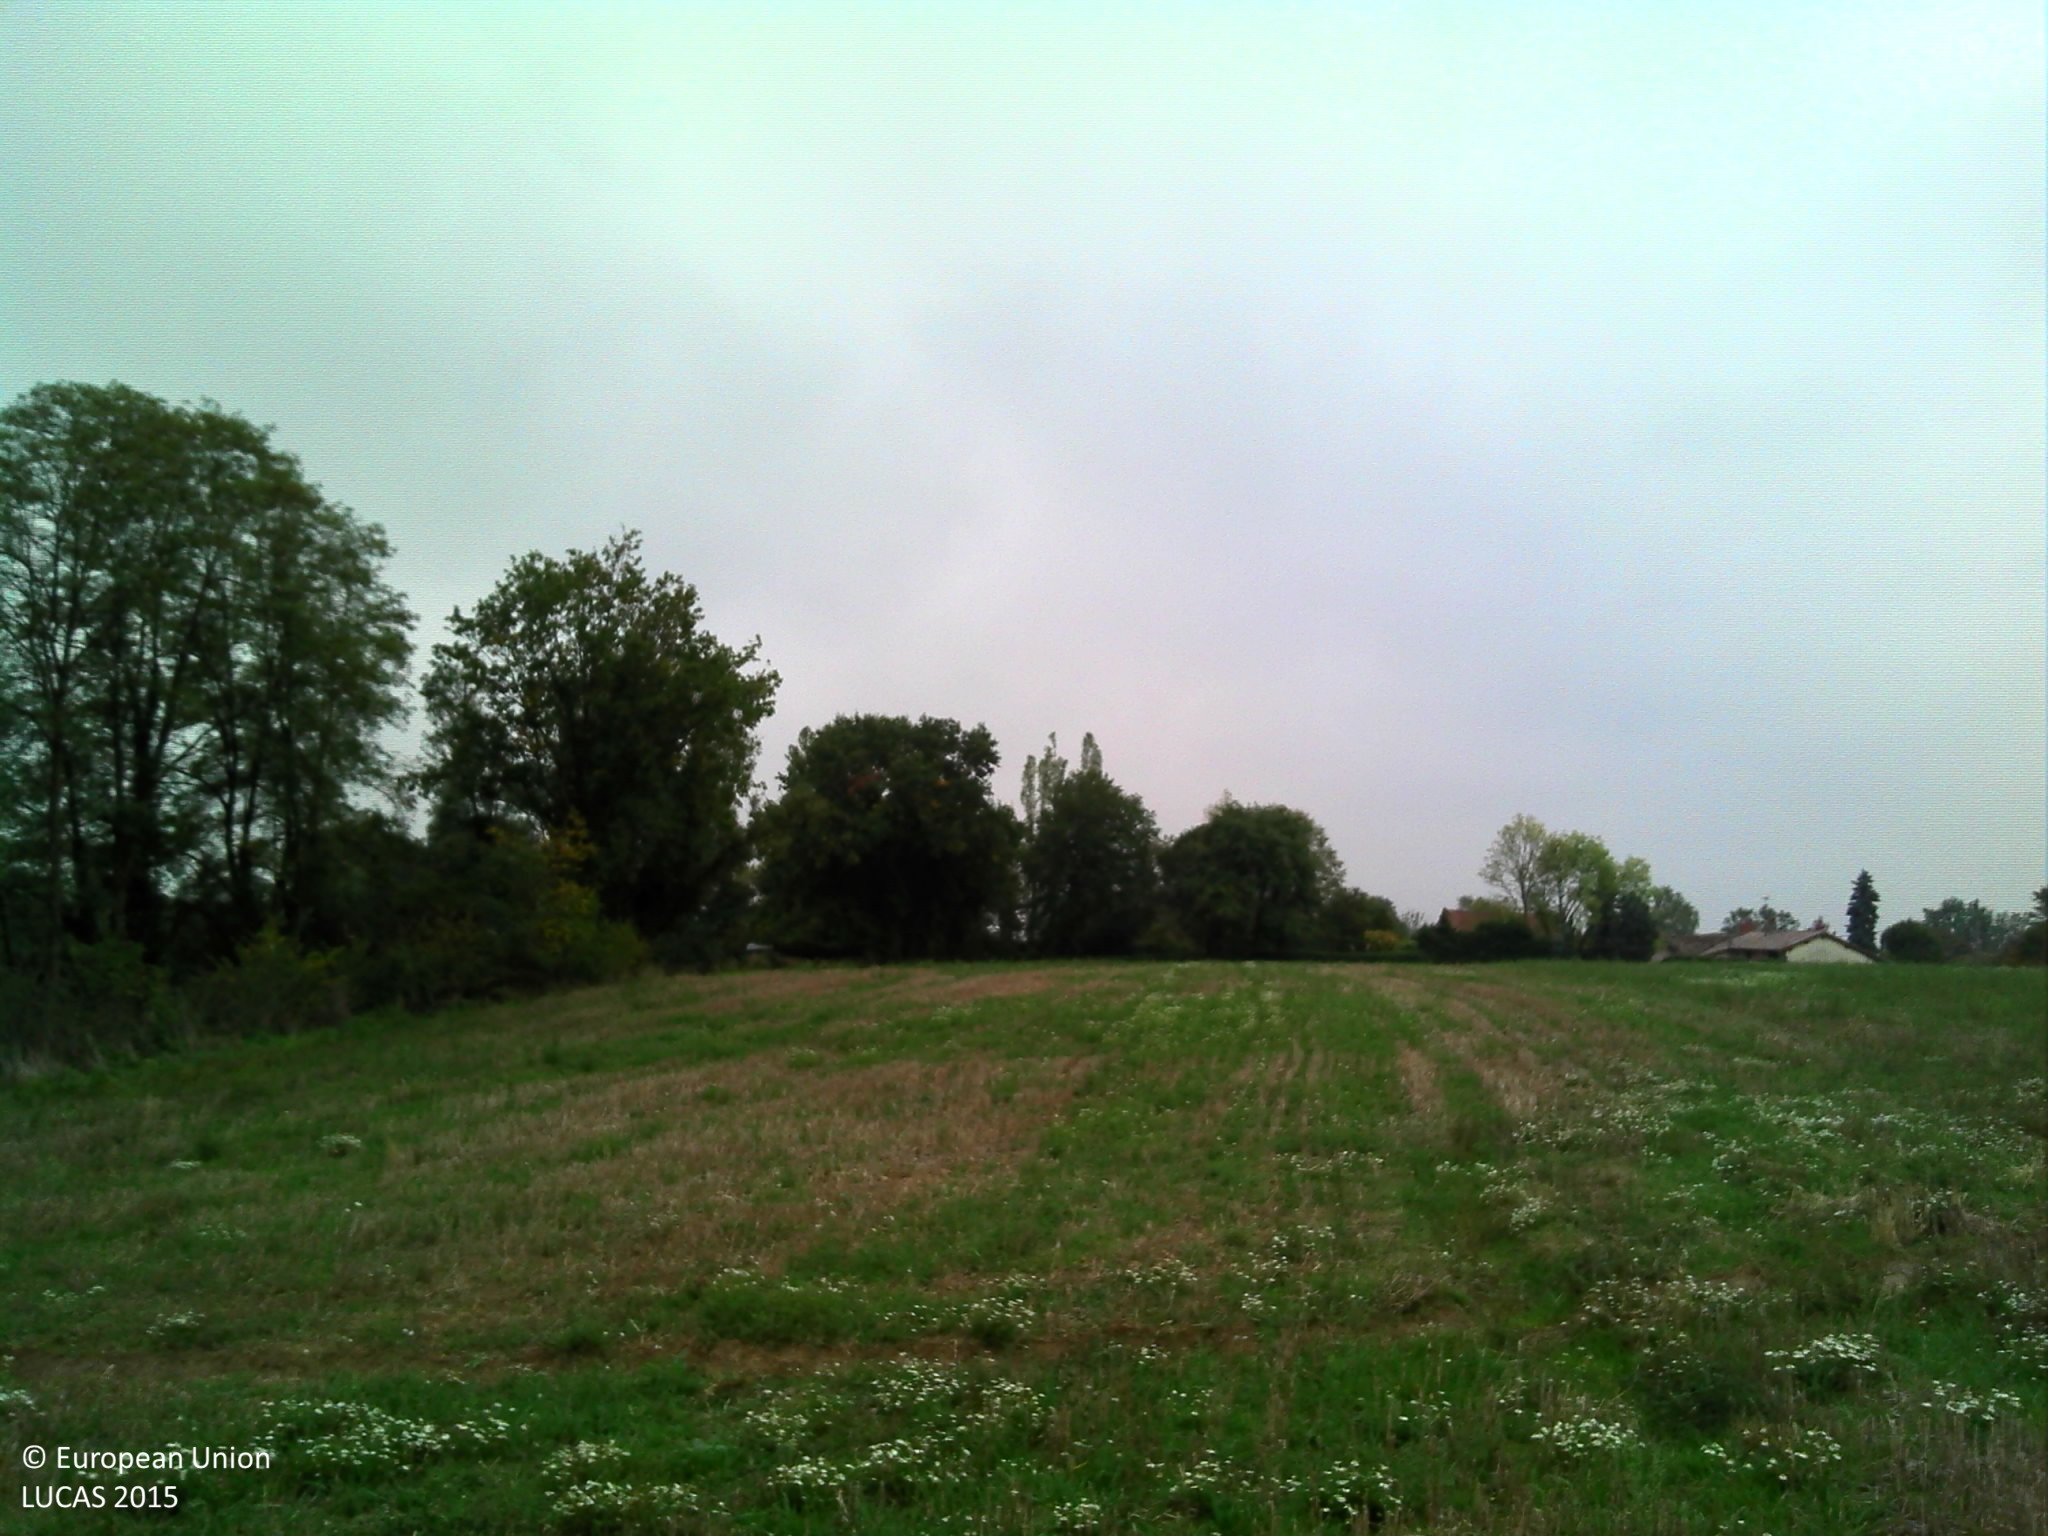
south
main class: Cropland
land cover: Common wheat
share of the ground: > 75 %
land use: Agriculture (excluding fallow land and kitchen gardens)
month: October
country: FR
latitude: 46.1568
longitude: 4.8878
